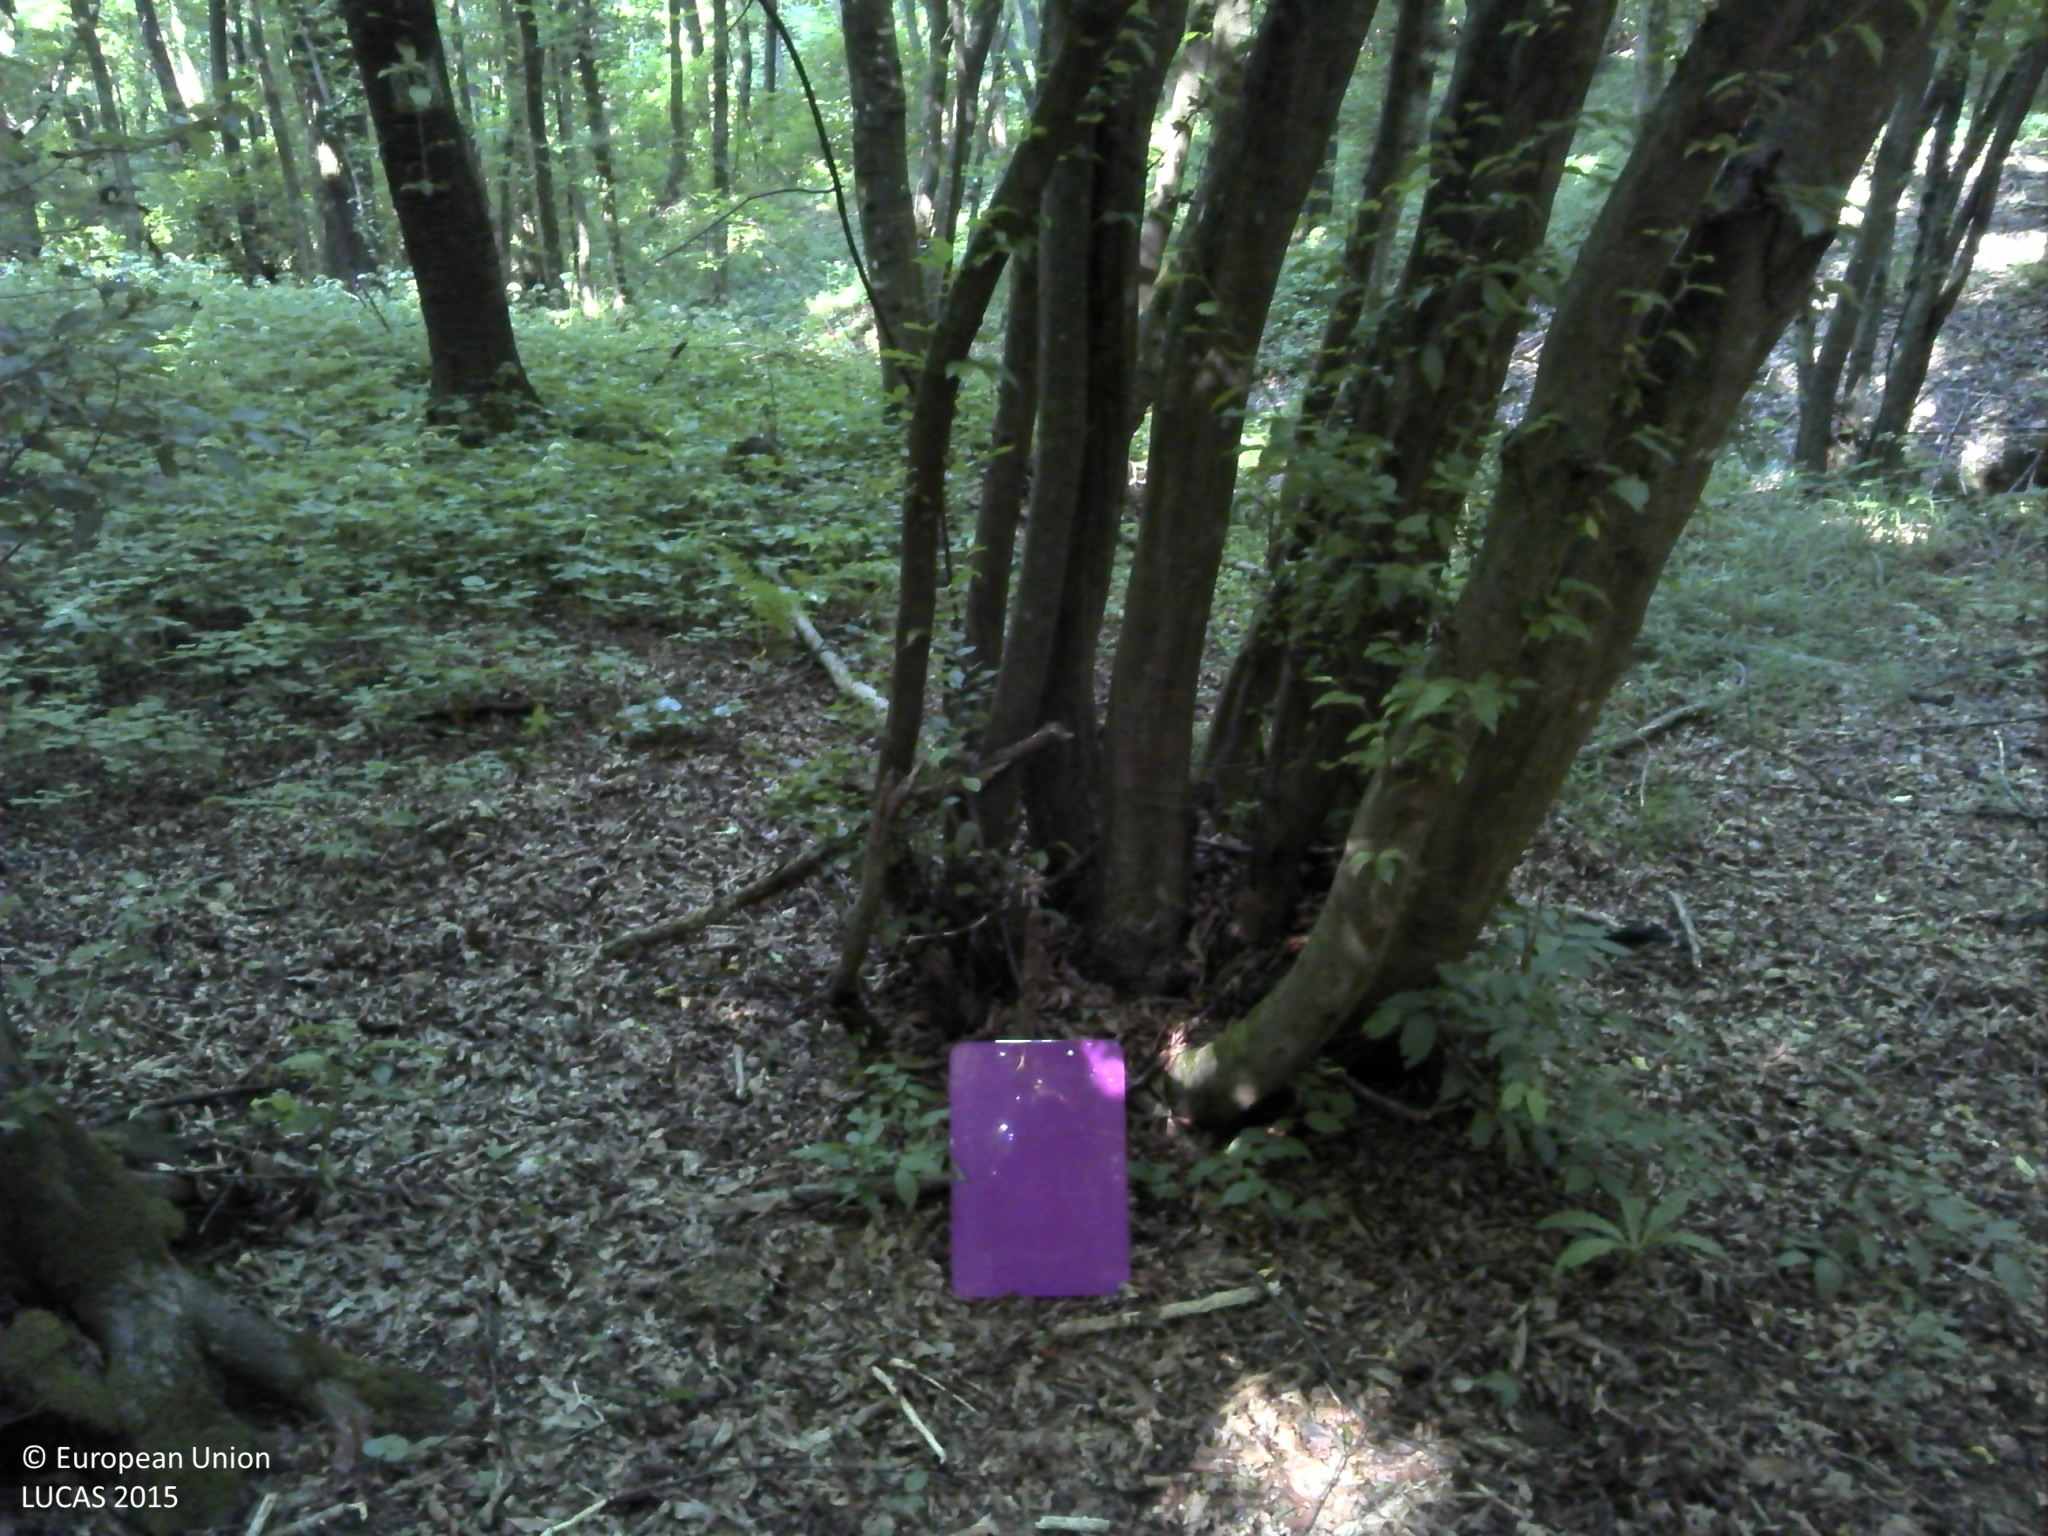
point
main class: Woodland
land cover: Broadleaved woodland
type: beech forest
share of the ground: > 75 %
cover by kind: broadleaved forest trees 80 %, lichens and mosses 20 %
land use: Forestry
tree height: > 5 m
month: June
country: HR
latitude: 45.3714
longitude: 17.6500
